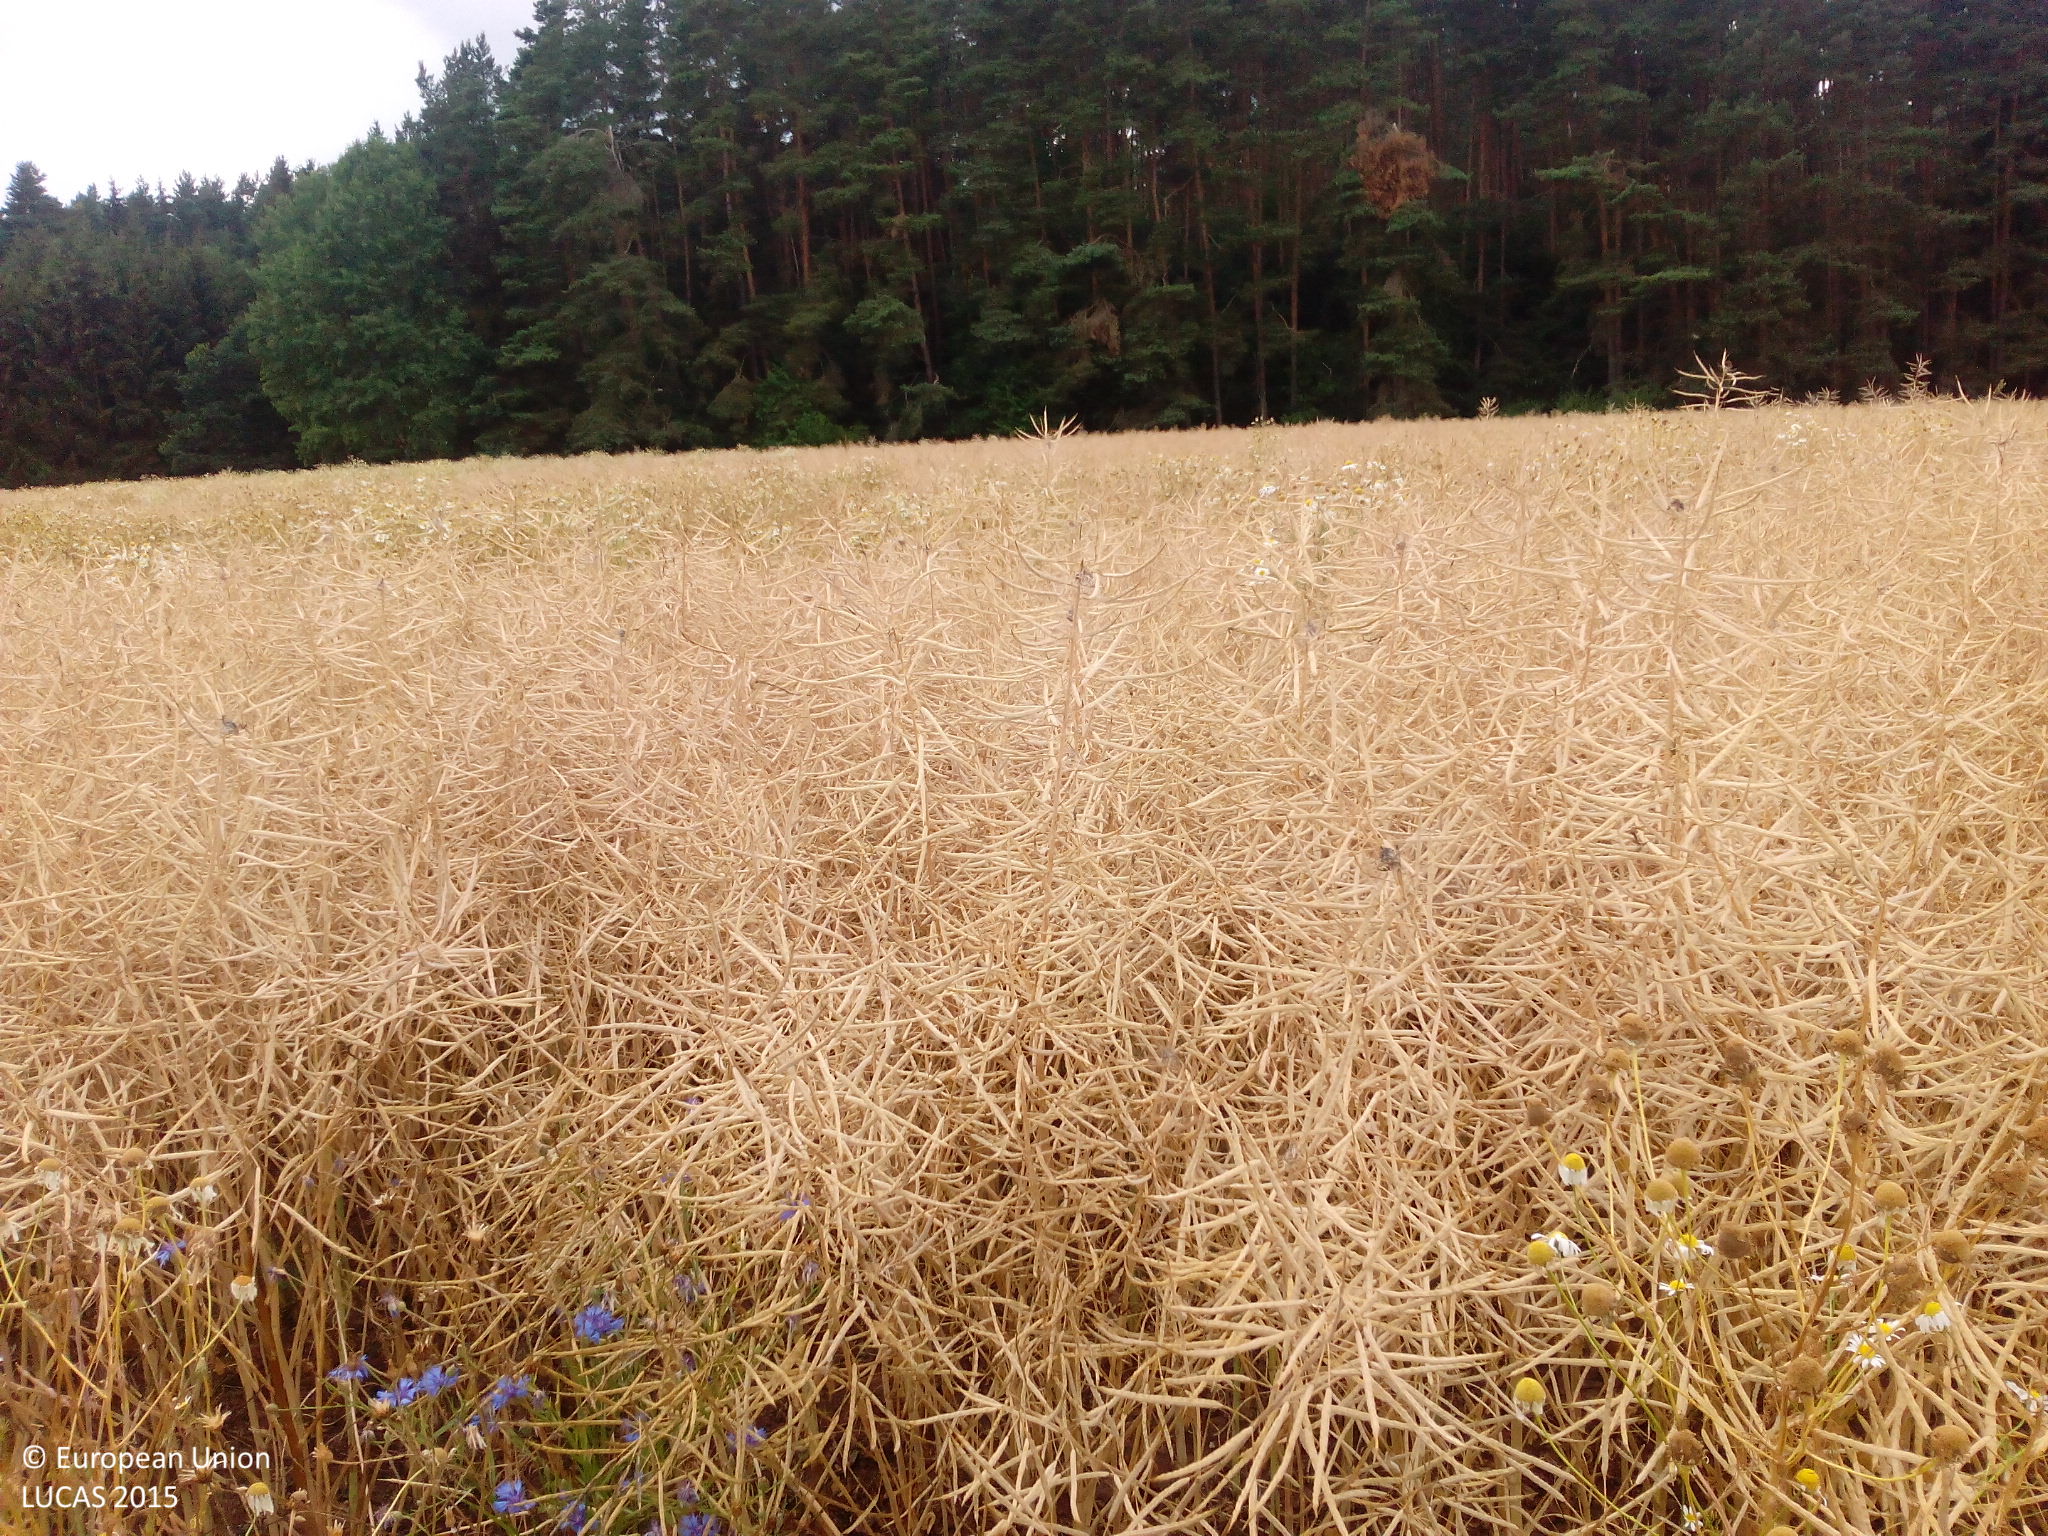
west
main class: Cropland
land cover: Rape and turnip rape
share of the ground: > 75 %
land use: Agriculture (excluding fallow land and kitchen gardens)
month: July
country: DE
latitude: 49.4811
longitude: 10.6209
